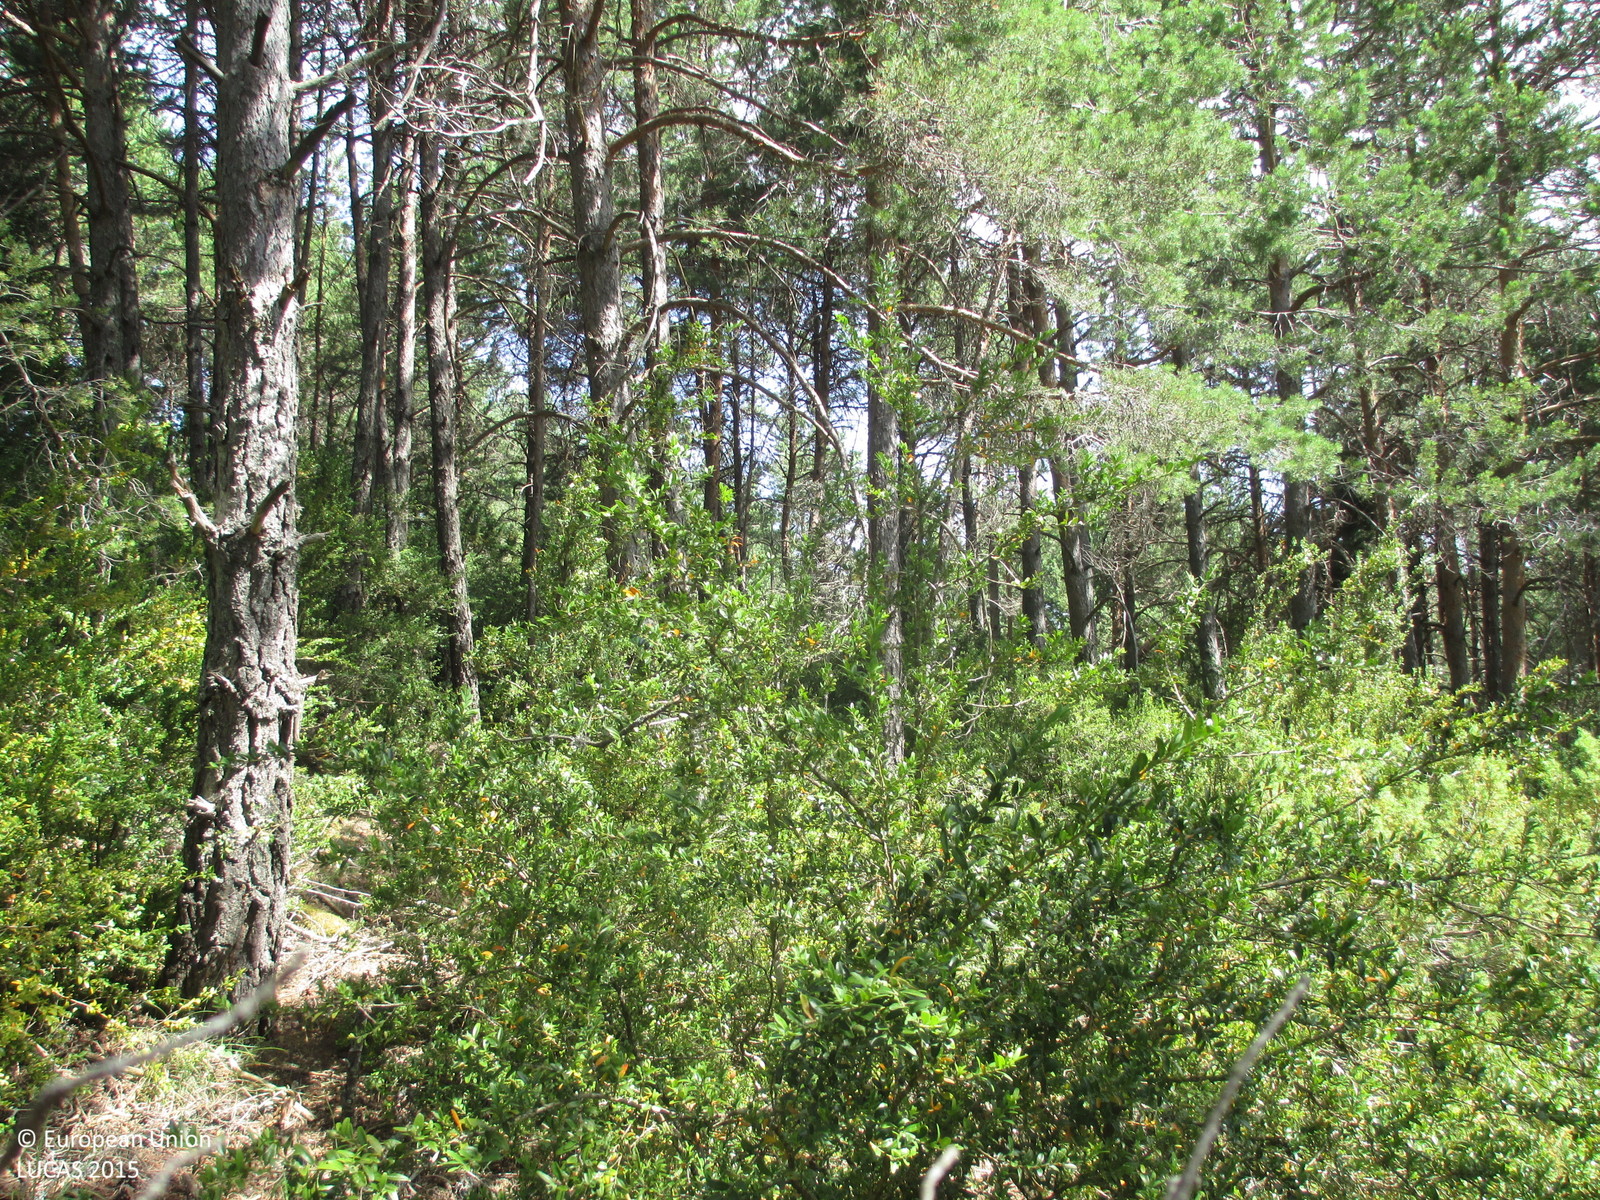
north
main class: Woodland
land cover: Pine dominated coniferous woodland
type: coniferous forest of the mediterranean region
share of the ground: > 75 %
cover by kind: coniferous forest trees 95 %, shrubs 5 %
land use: Semi-natural and natural areas not in use
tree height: > 5 m
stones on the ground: < 10 %
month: July
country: ES
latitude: 42.3503
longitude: -0.2569
